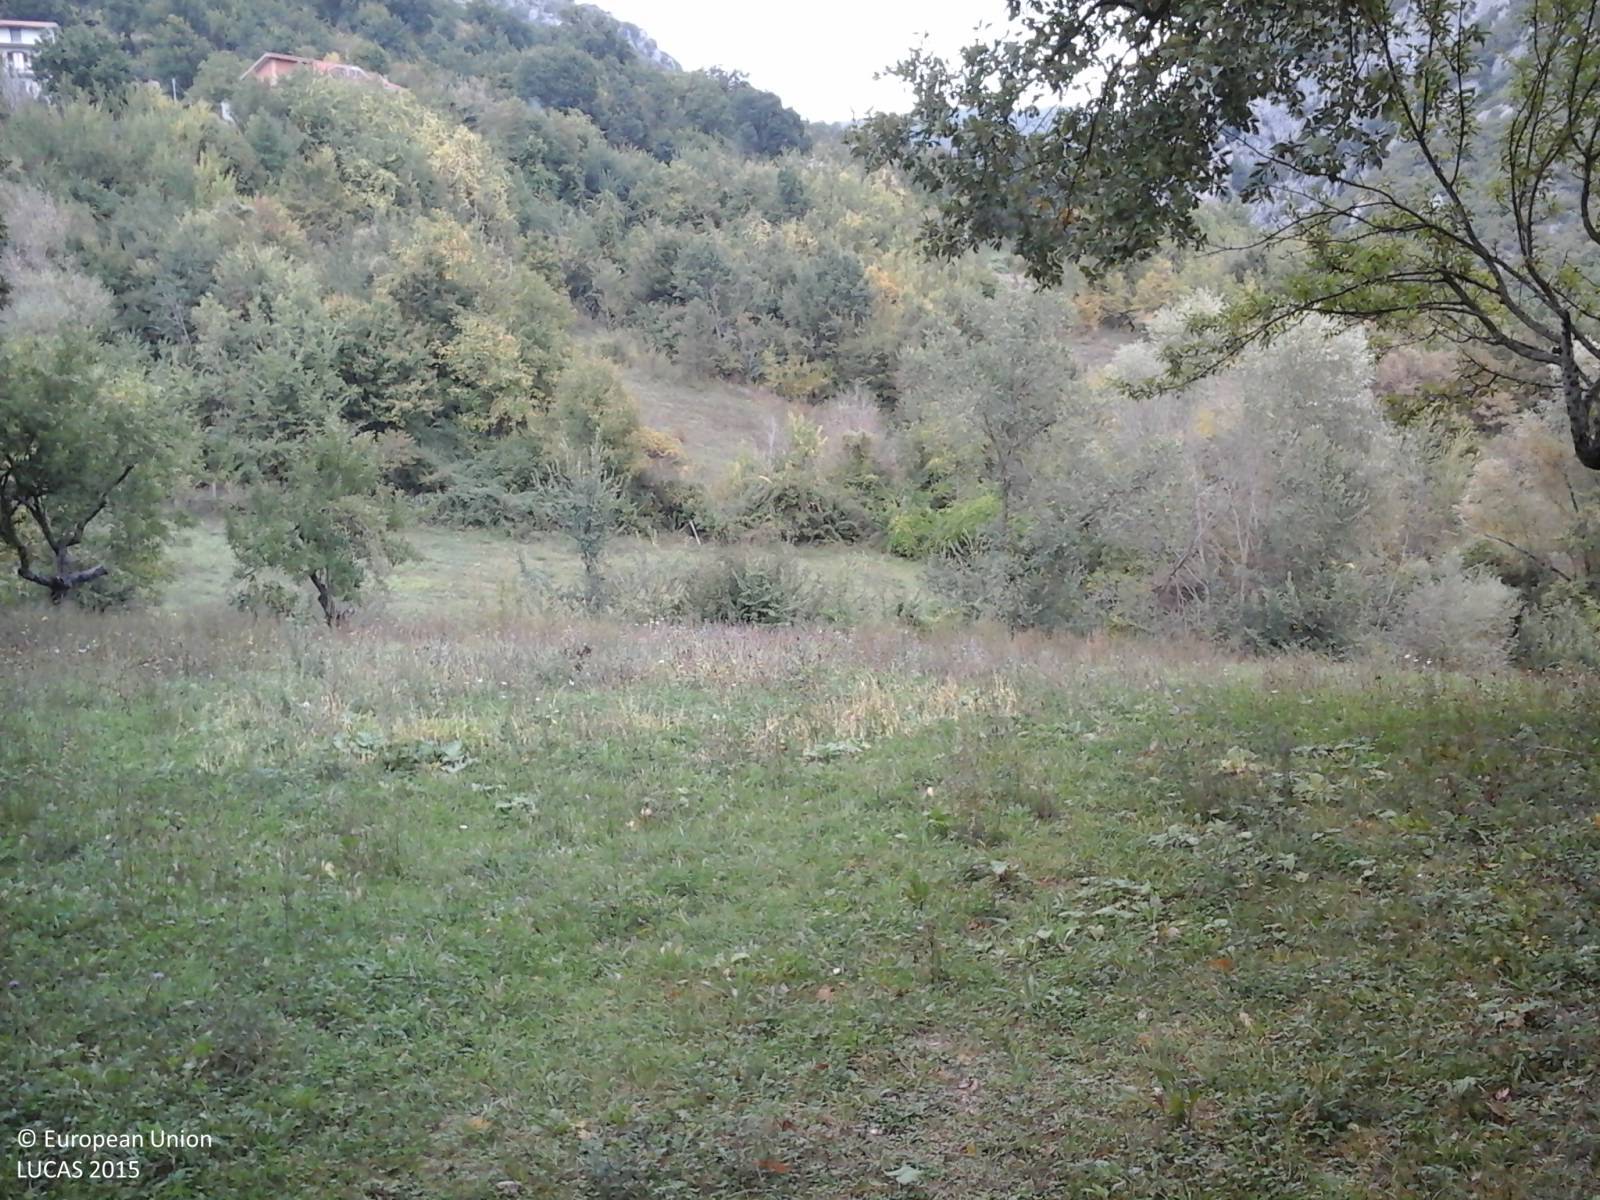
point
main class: Grassland
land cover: Grassland without tree/shrub cover
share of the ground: > 75 %
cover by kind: herbaceous plants 100 %
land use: Agriculture (excluding fallow land and kitchen gardens)
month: October
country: IT
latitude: 42.2608
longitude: 13.1776
